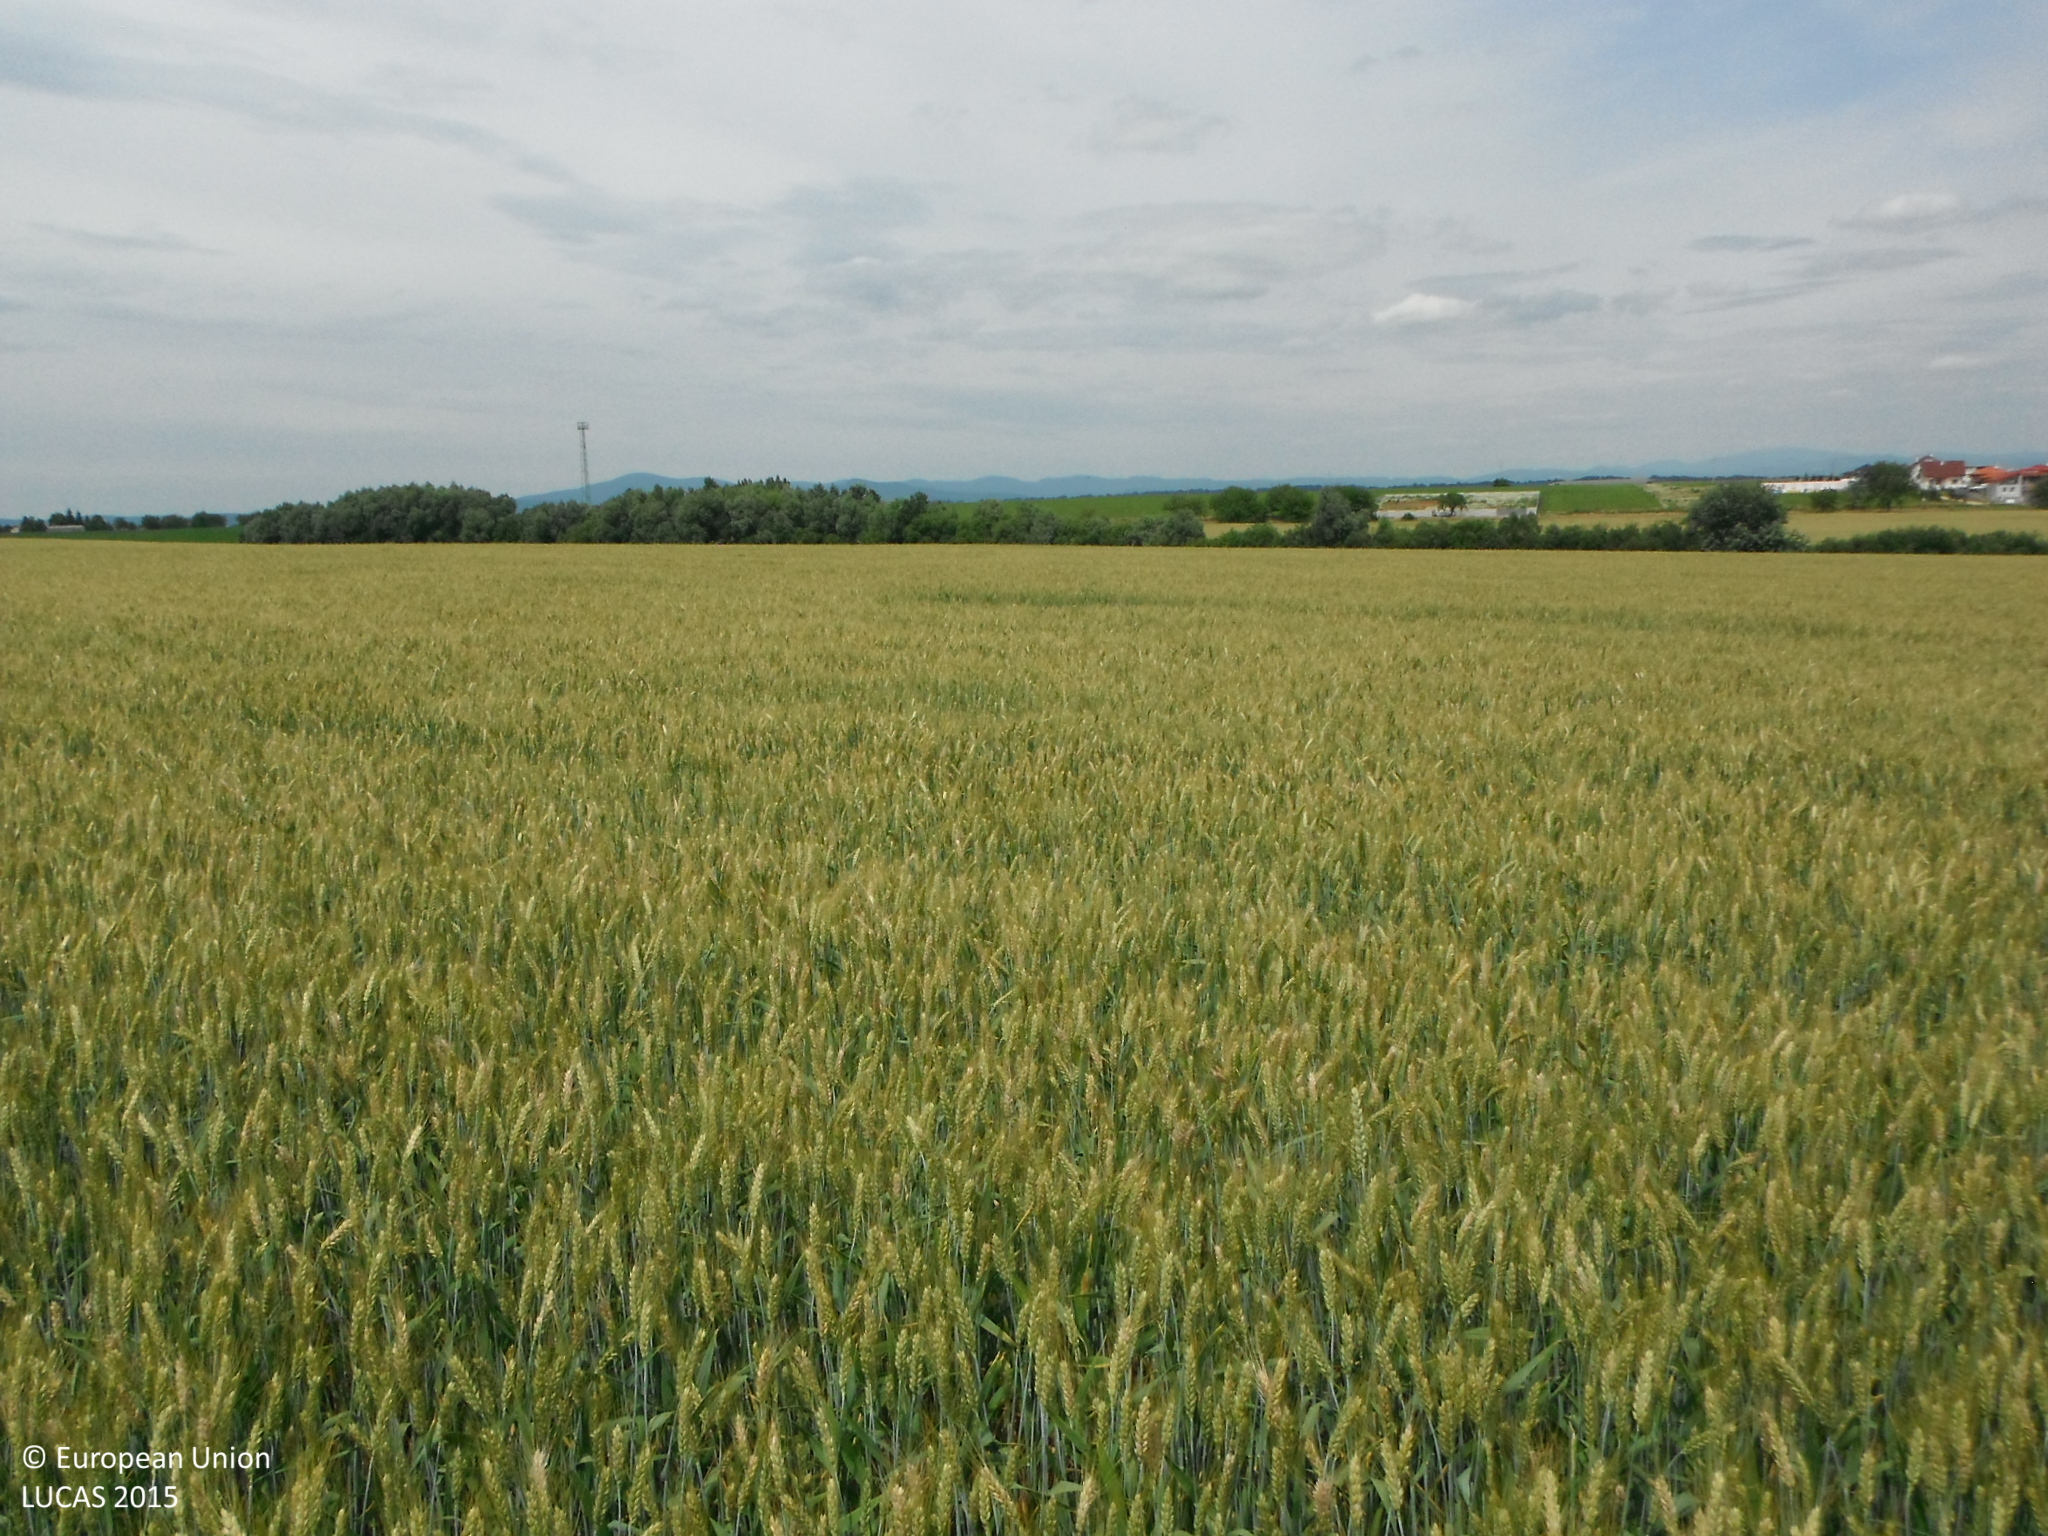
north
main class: Cropland
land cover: Common wheat
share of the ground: > 75 %
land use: Agriculture (excluding fallow land and kitchen gardens)
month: June
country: SK
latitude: 48.2759
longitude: 18.2475
